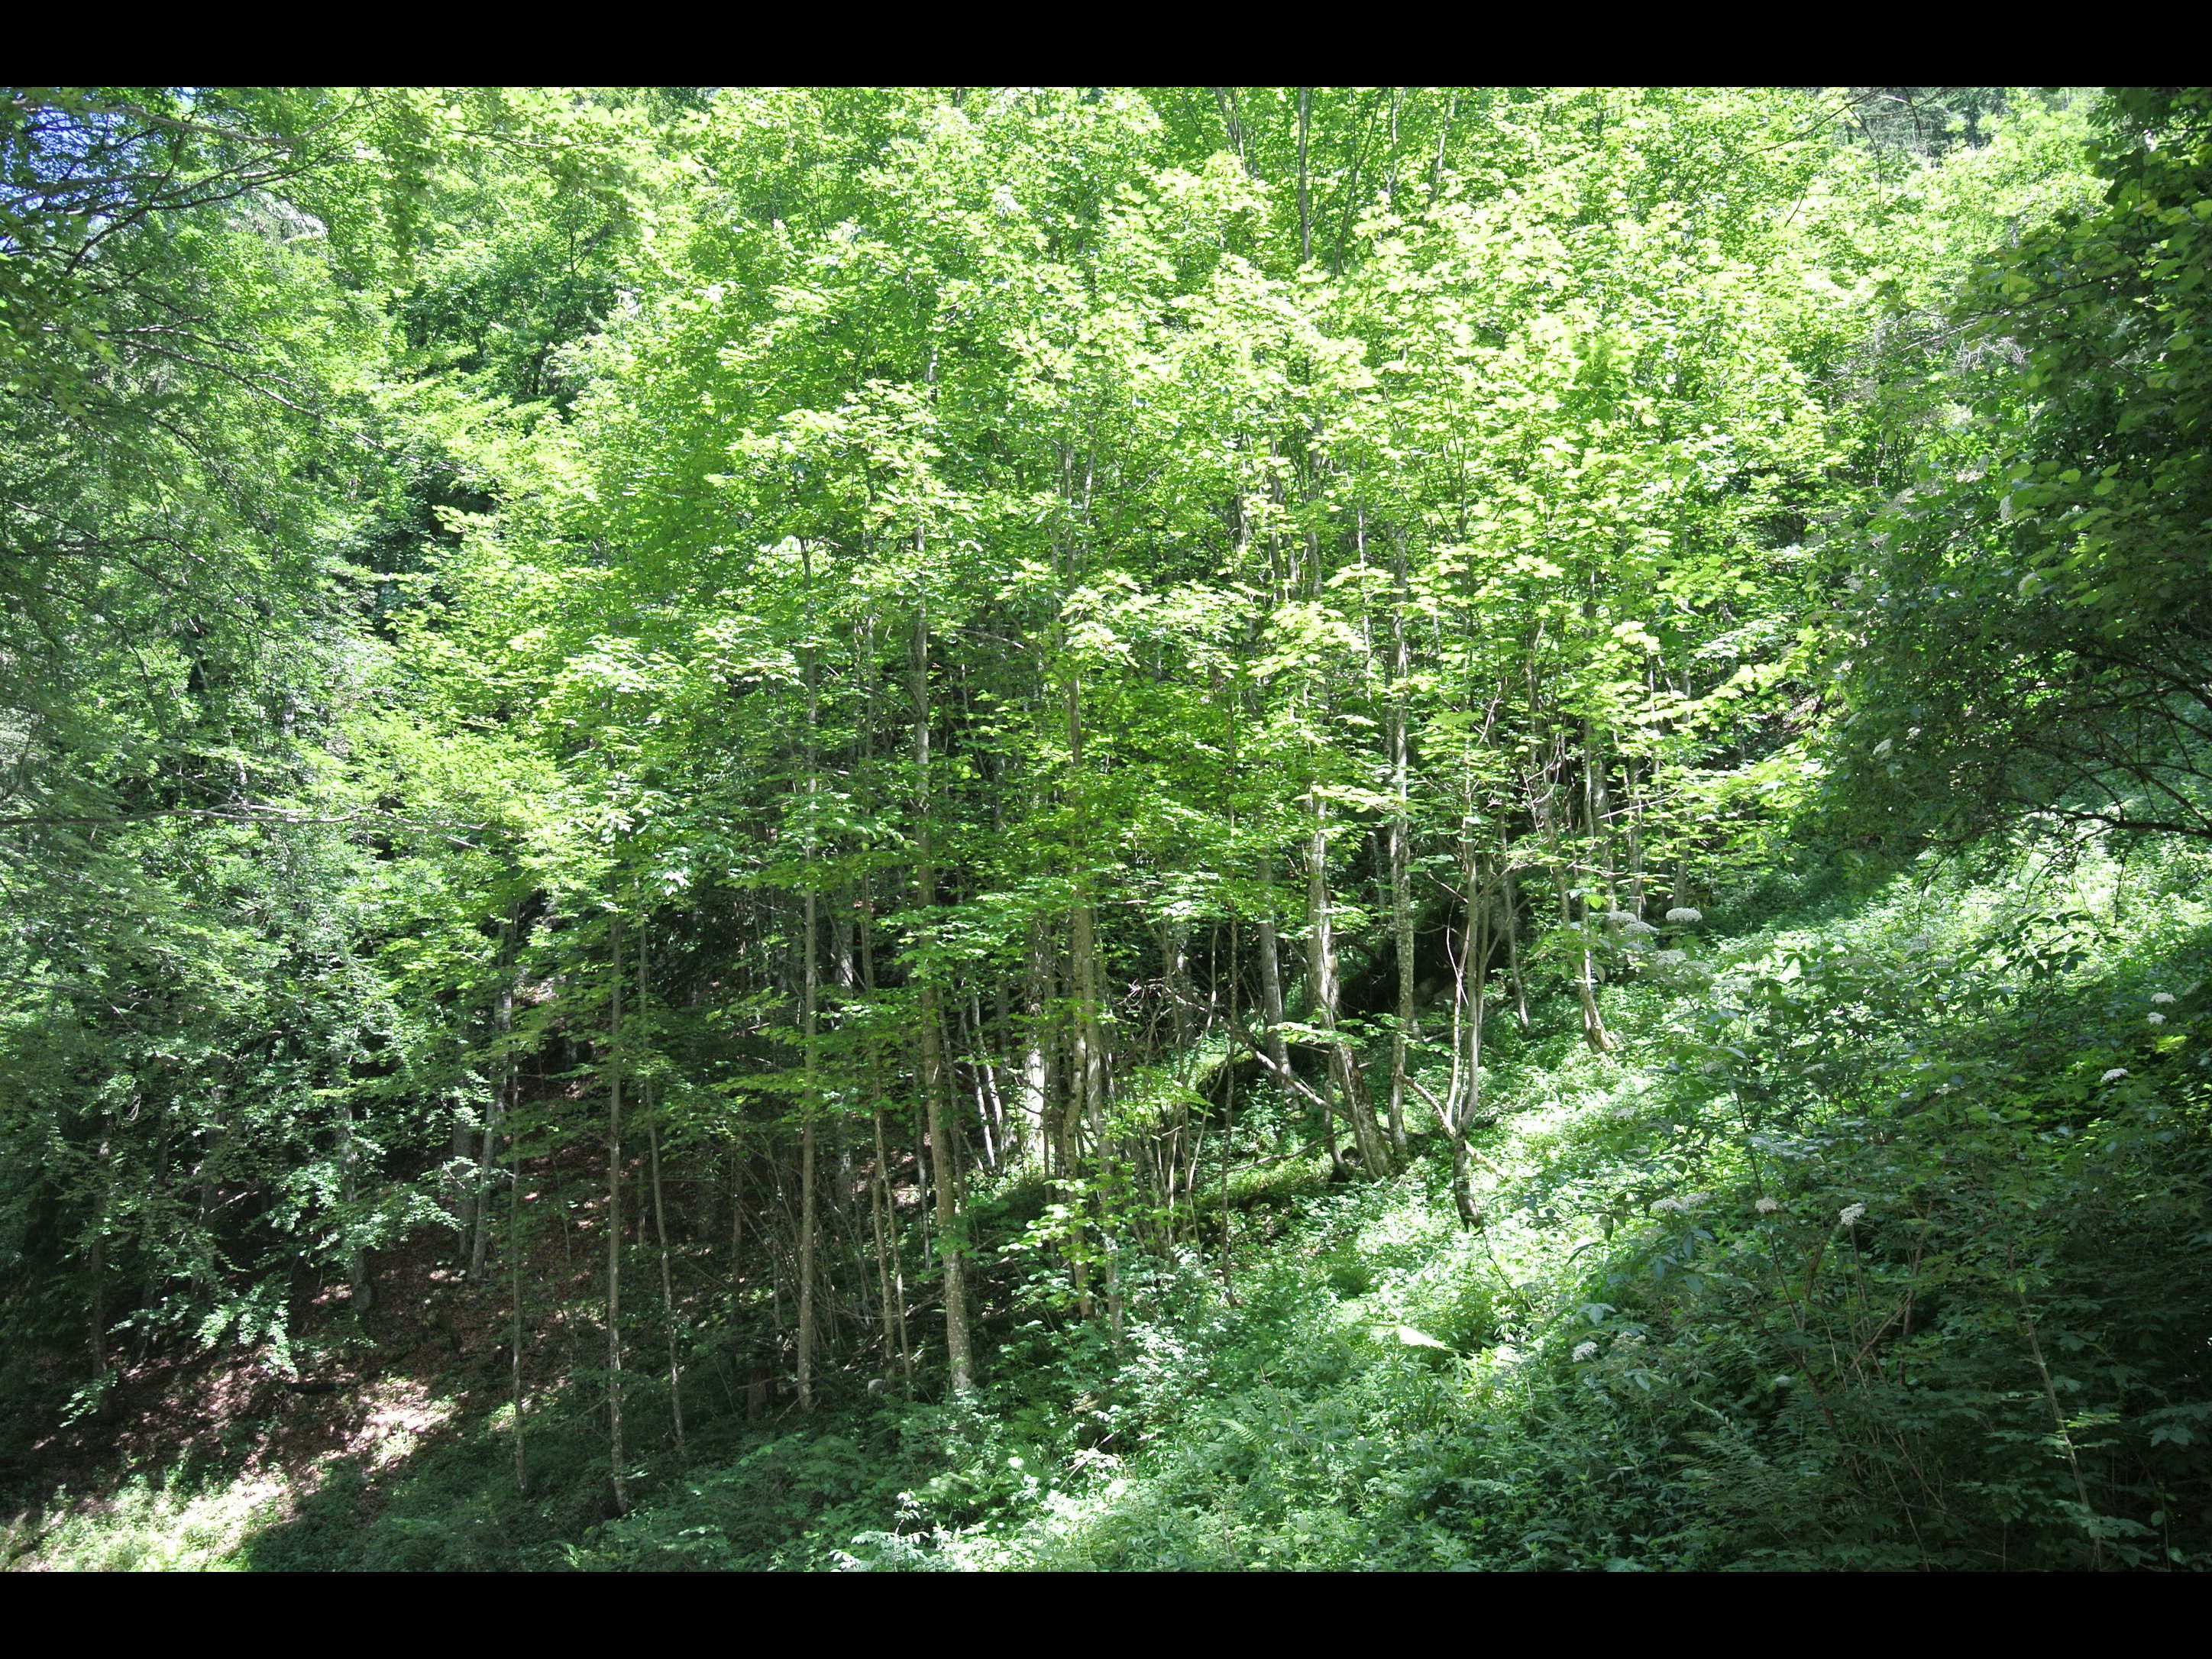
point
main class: Woodland
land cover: Broadleaved woodland
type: alpine coniferous forest
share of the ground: > 75 %
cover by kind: broadleaved forest trees 85 %, herbaceous plants 15 %
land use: Forestry
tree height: > 5 m
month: June
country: AT
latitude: 47.9291
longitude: 15.3954
